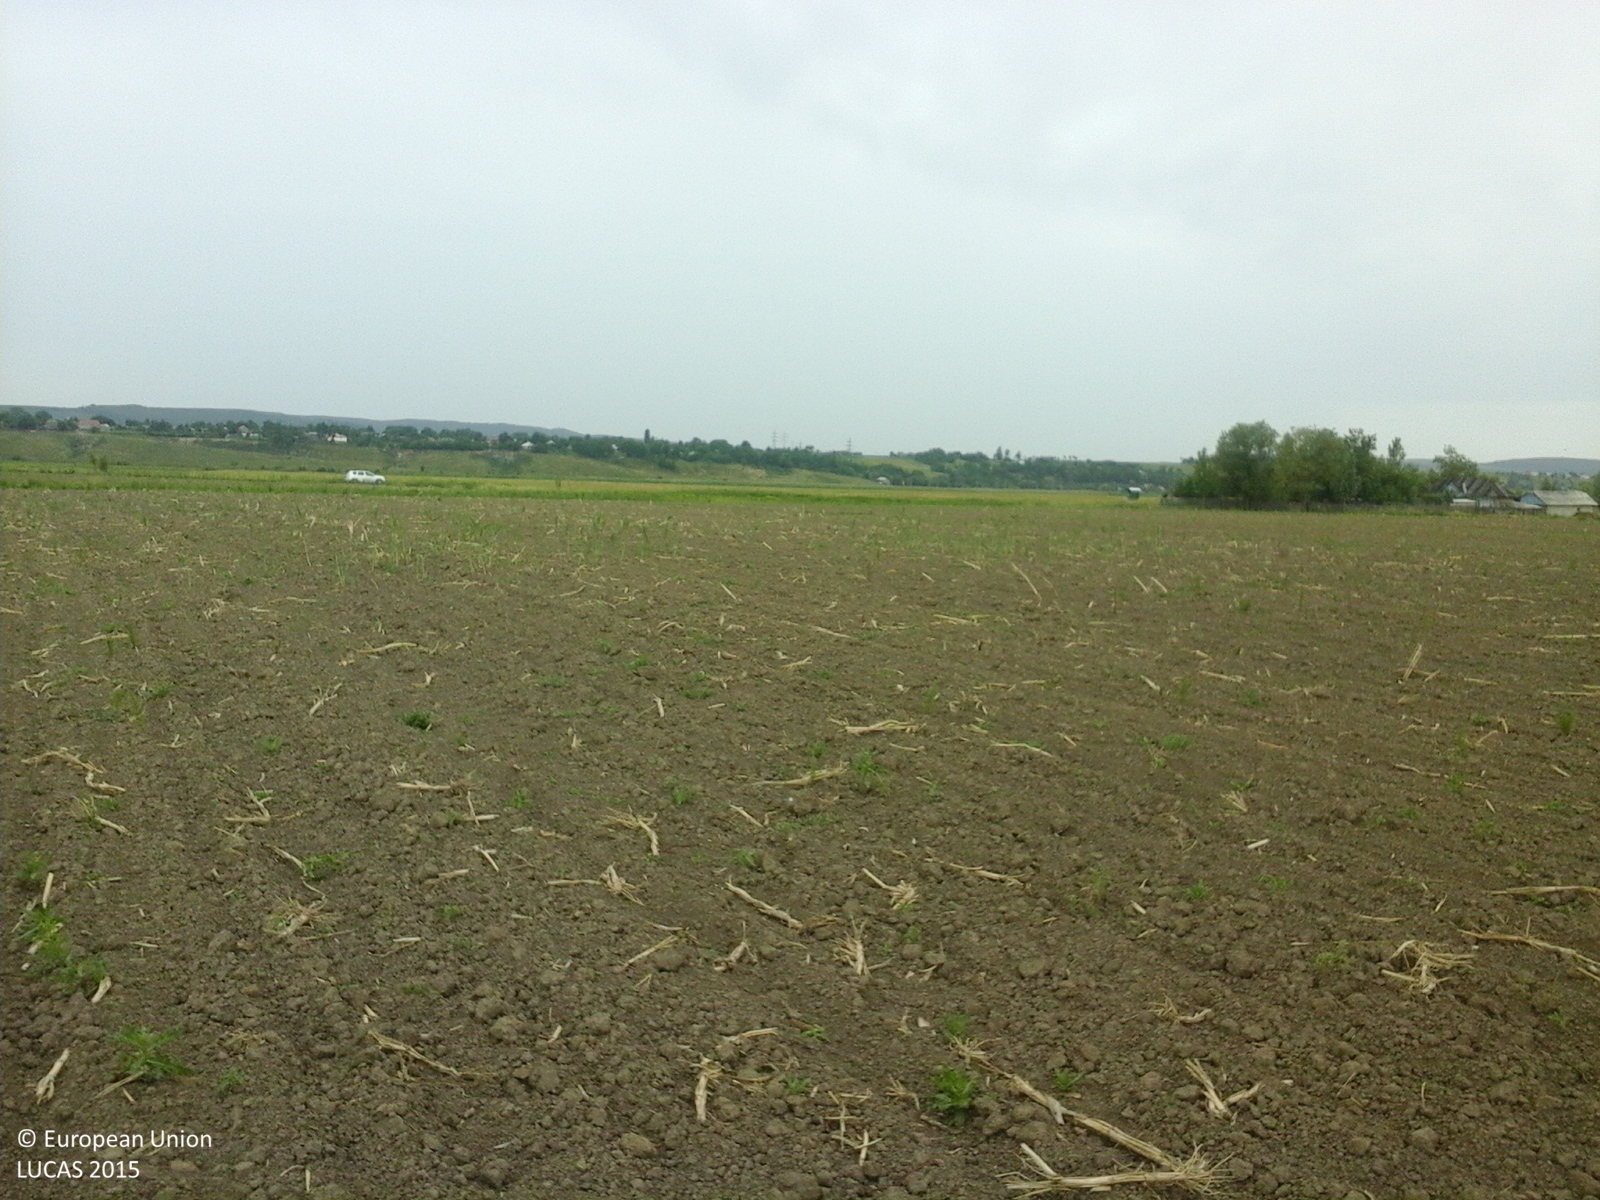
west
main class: Cropland
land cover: Sunflower
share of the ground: < 10 %
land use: Agriculture (excluding fallow land and kitchen gardens)
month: June
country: RO
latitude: 47.3237
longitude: 26.6983
